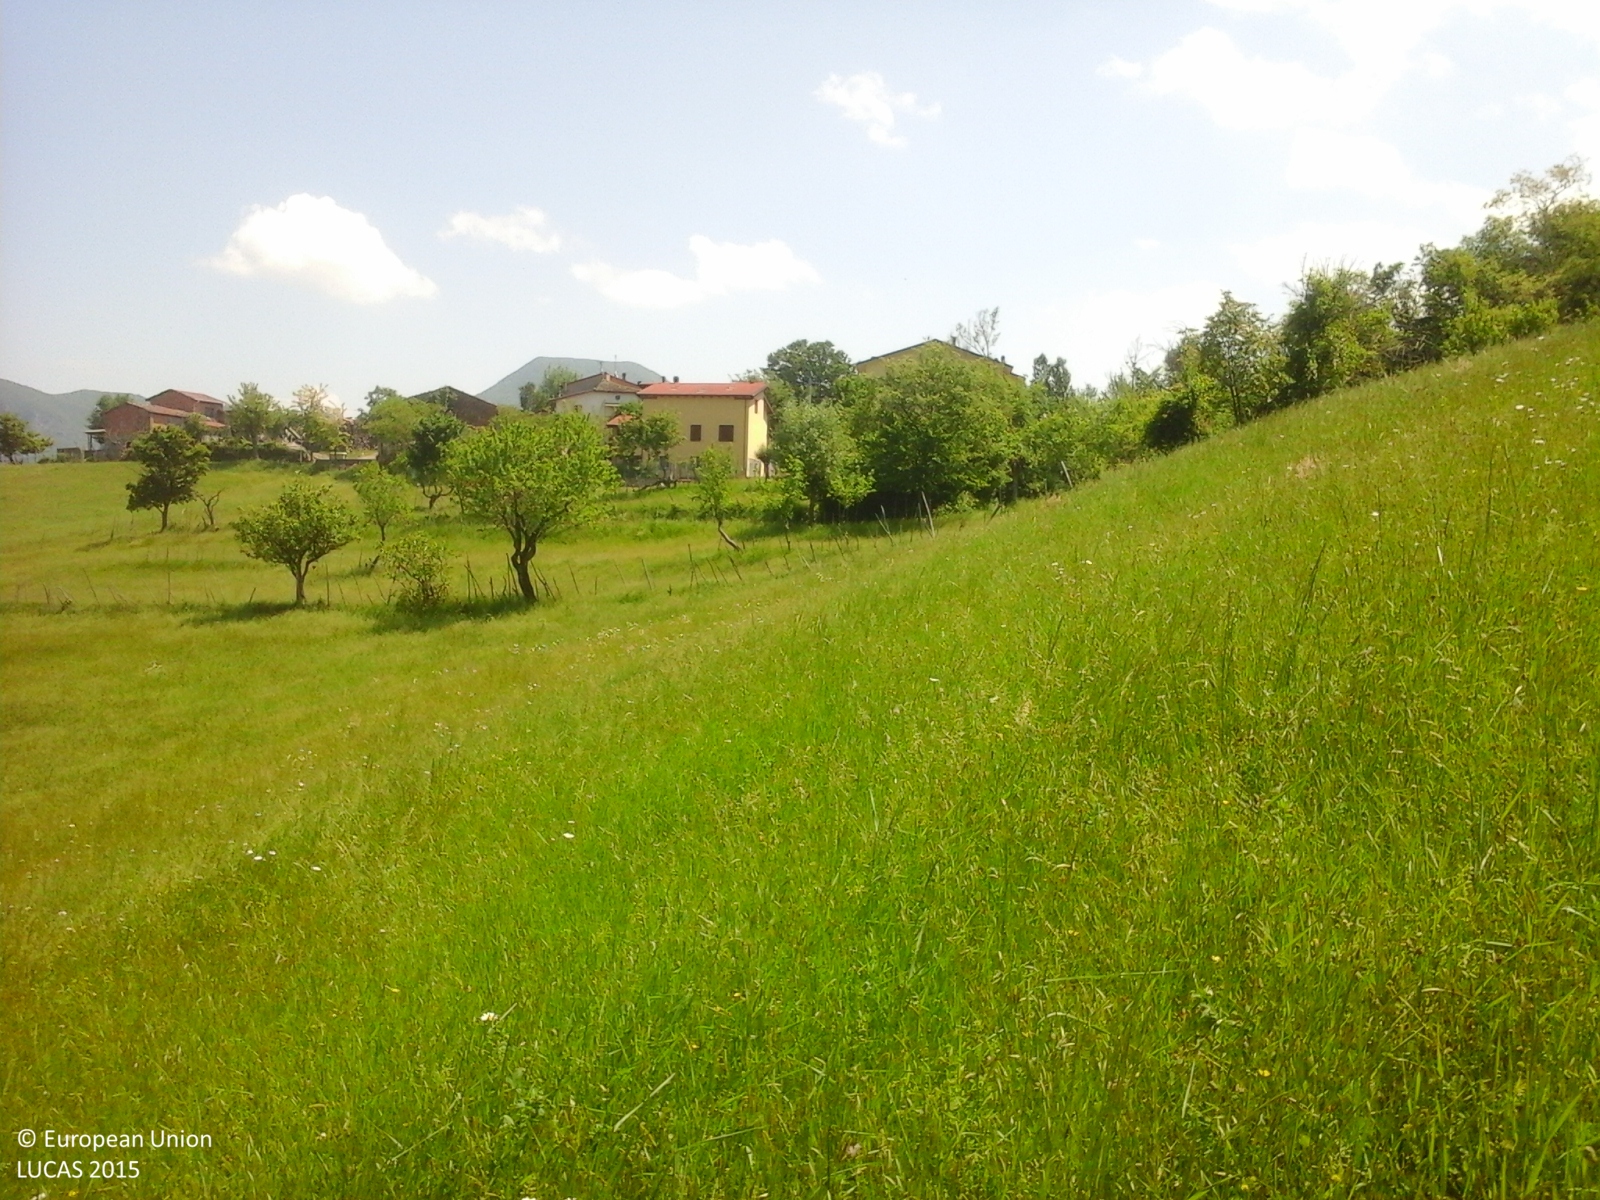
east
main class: Grassland
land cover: Grassland without tree/shrub cover
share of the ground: > 75 %
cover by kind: herbaceous plants 100 %
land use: Agriculture (excluding fallow land and kitchen gardens)
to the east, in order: Grassland without tree/shrub cover; Fences; Managed hedges; Grassland without tree/shrub cover; Fences; Managed hedges; Grassland without tree/shrub cover; Fences; Managed hedges; Grassland without tree/shrub cover; Artificial constructions in urban areas; Apple fruit; Grassland without tree/shrub cover
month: May
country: IT
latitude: 44.2011
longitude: 11.0361
